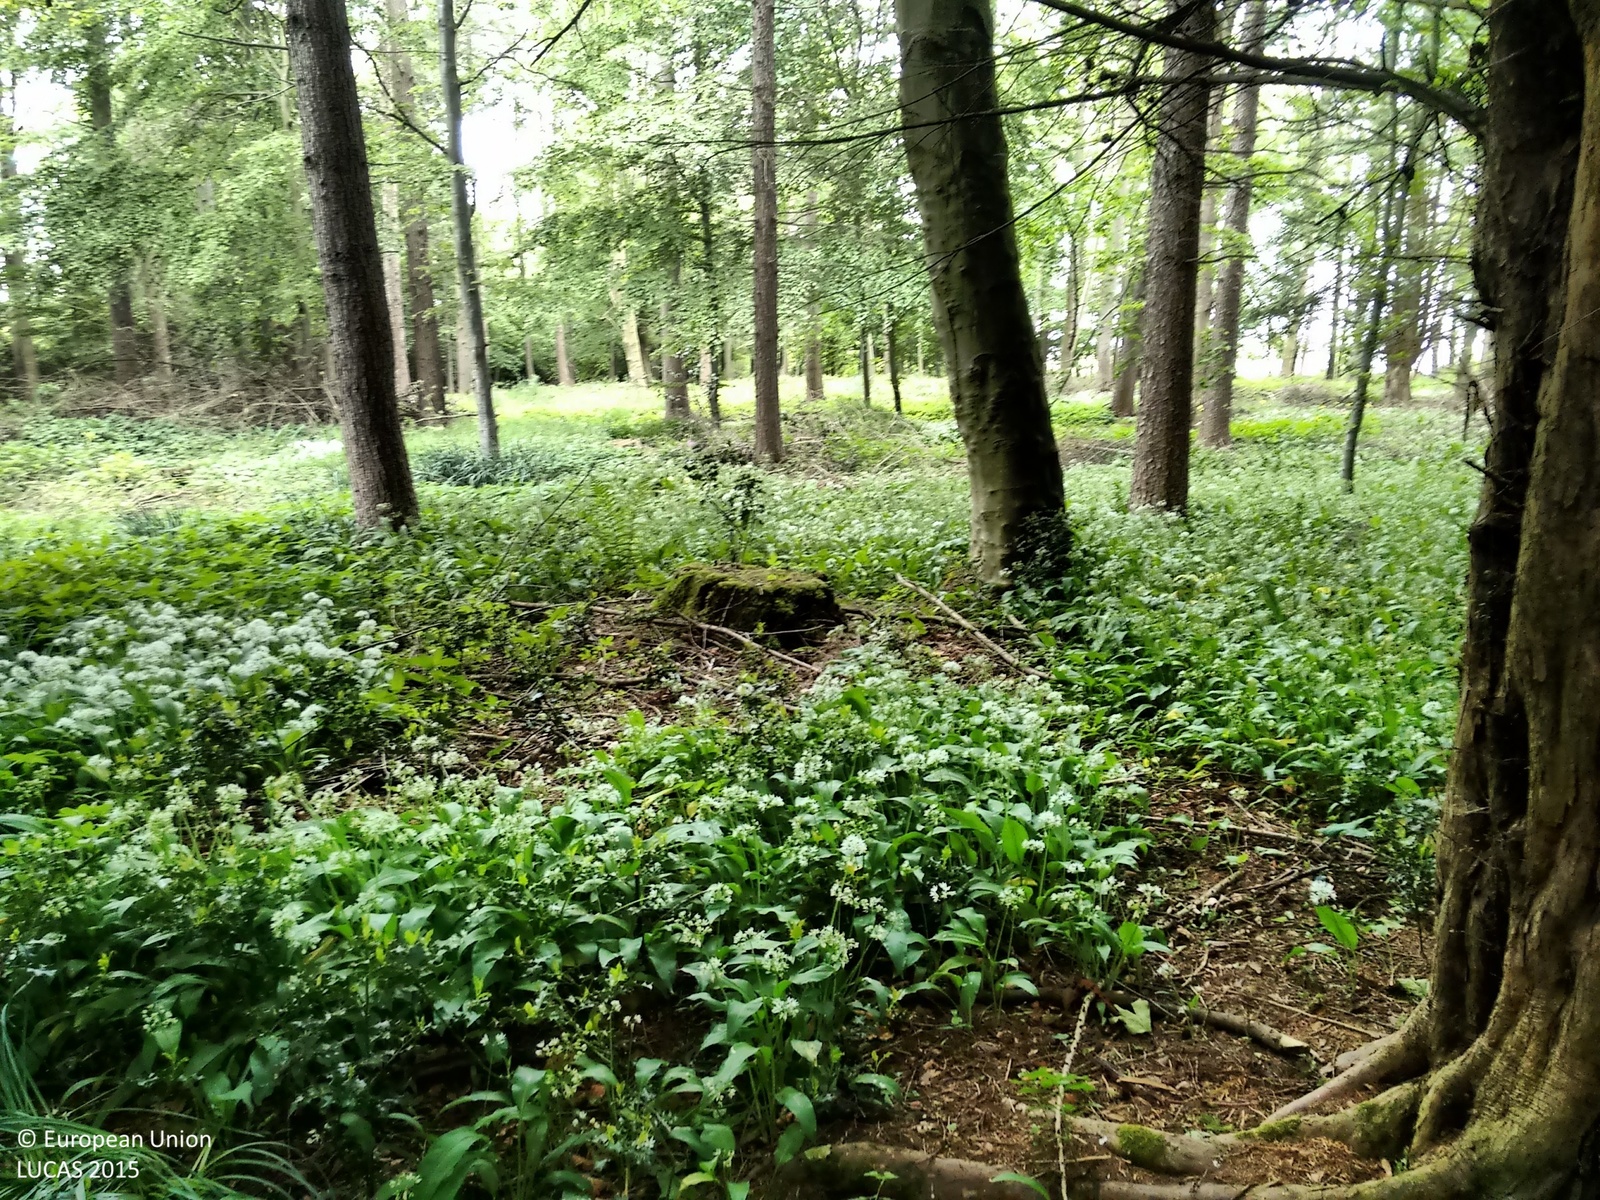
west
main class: Woodland
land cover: Other mixed woodland
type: exotic forest
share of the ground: > 75 %
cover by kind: broadleaved forest trees 75 %, coniferous forest trees 25 %
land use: Semi-natural and natural areas not in use
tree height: > 5 m
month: June
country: GB
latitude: 55.5506
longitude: -1.7955
